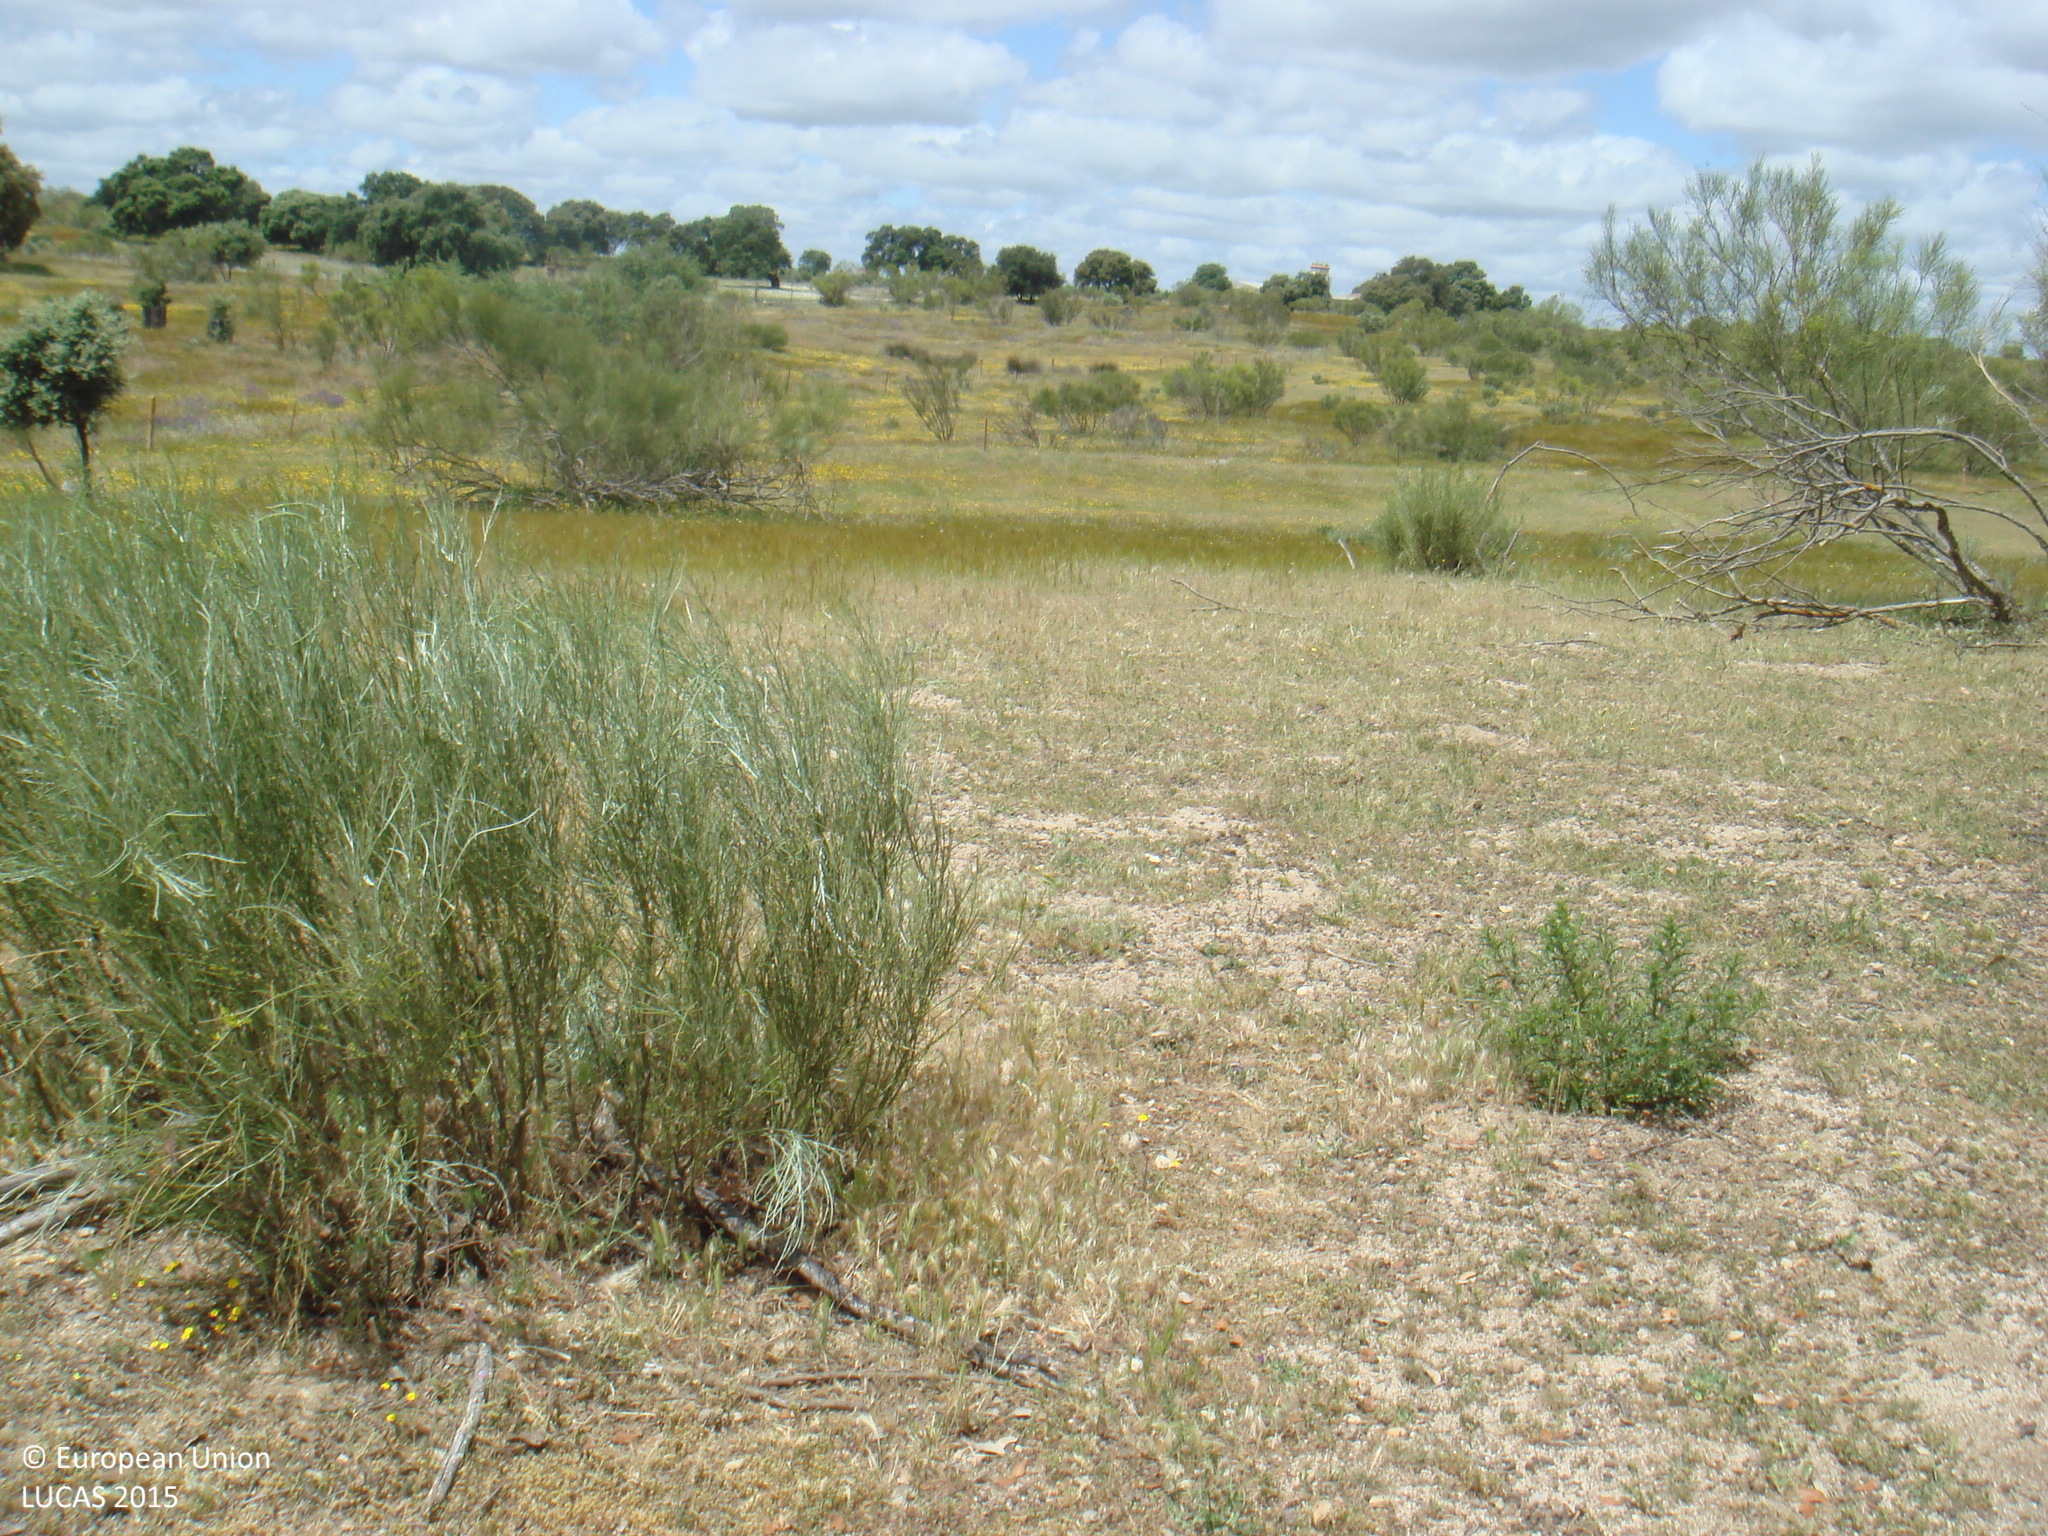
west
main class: Woodland
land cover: Broadleaved woodland
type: broadleaved evergreen forest
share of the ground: 25 - 50 %
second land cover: Shrubland without tree cover
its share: 10 - 25 %
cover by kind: broadleaved forest trees 40 %, herbaceous plants 40 %, shrubs 20 %
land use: Forestry
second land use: Agriculture (excluding fallow land and kitchen gardens)
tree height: > 5 m
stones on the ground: < 10 %
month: May
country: ES
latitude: 38.4408
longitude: -4.6755
